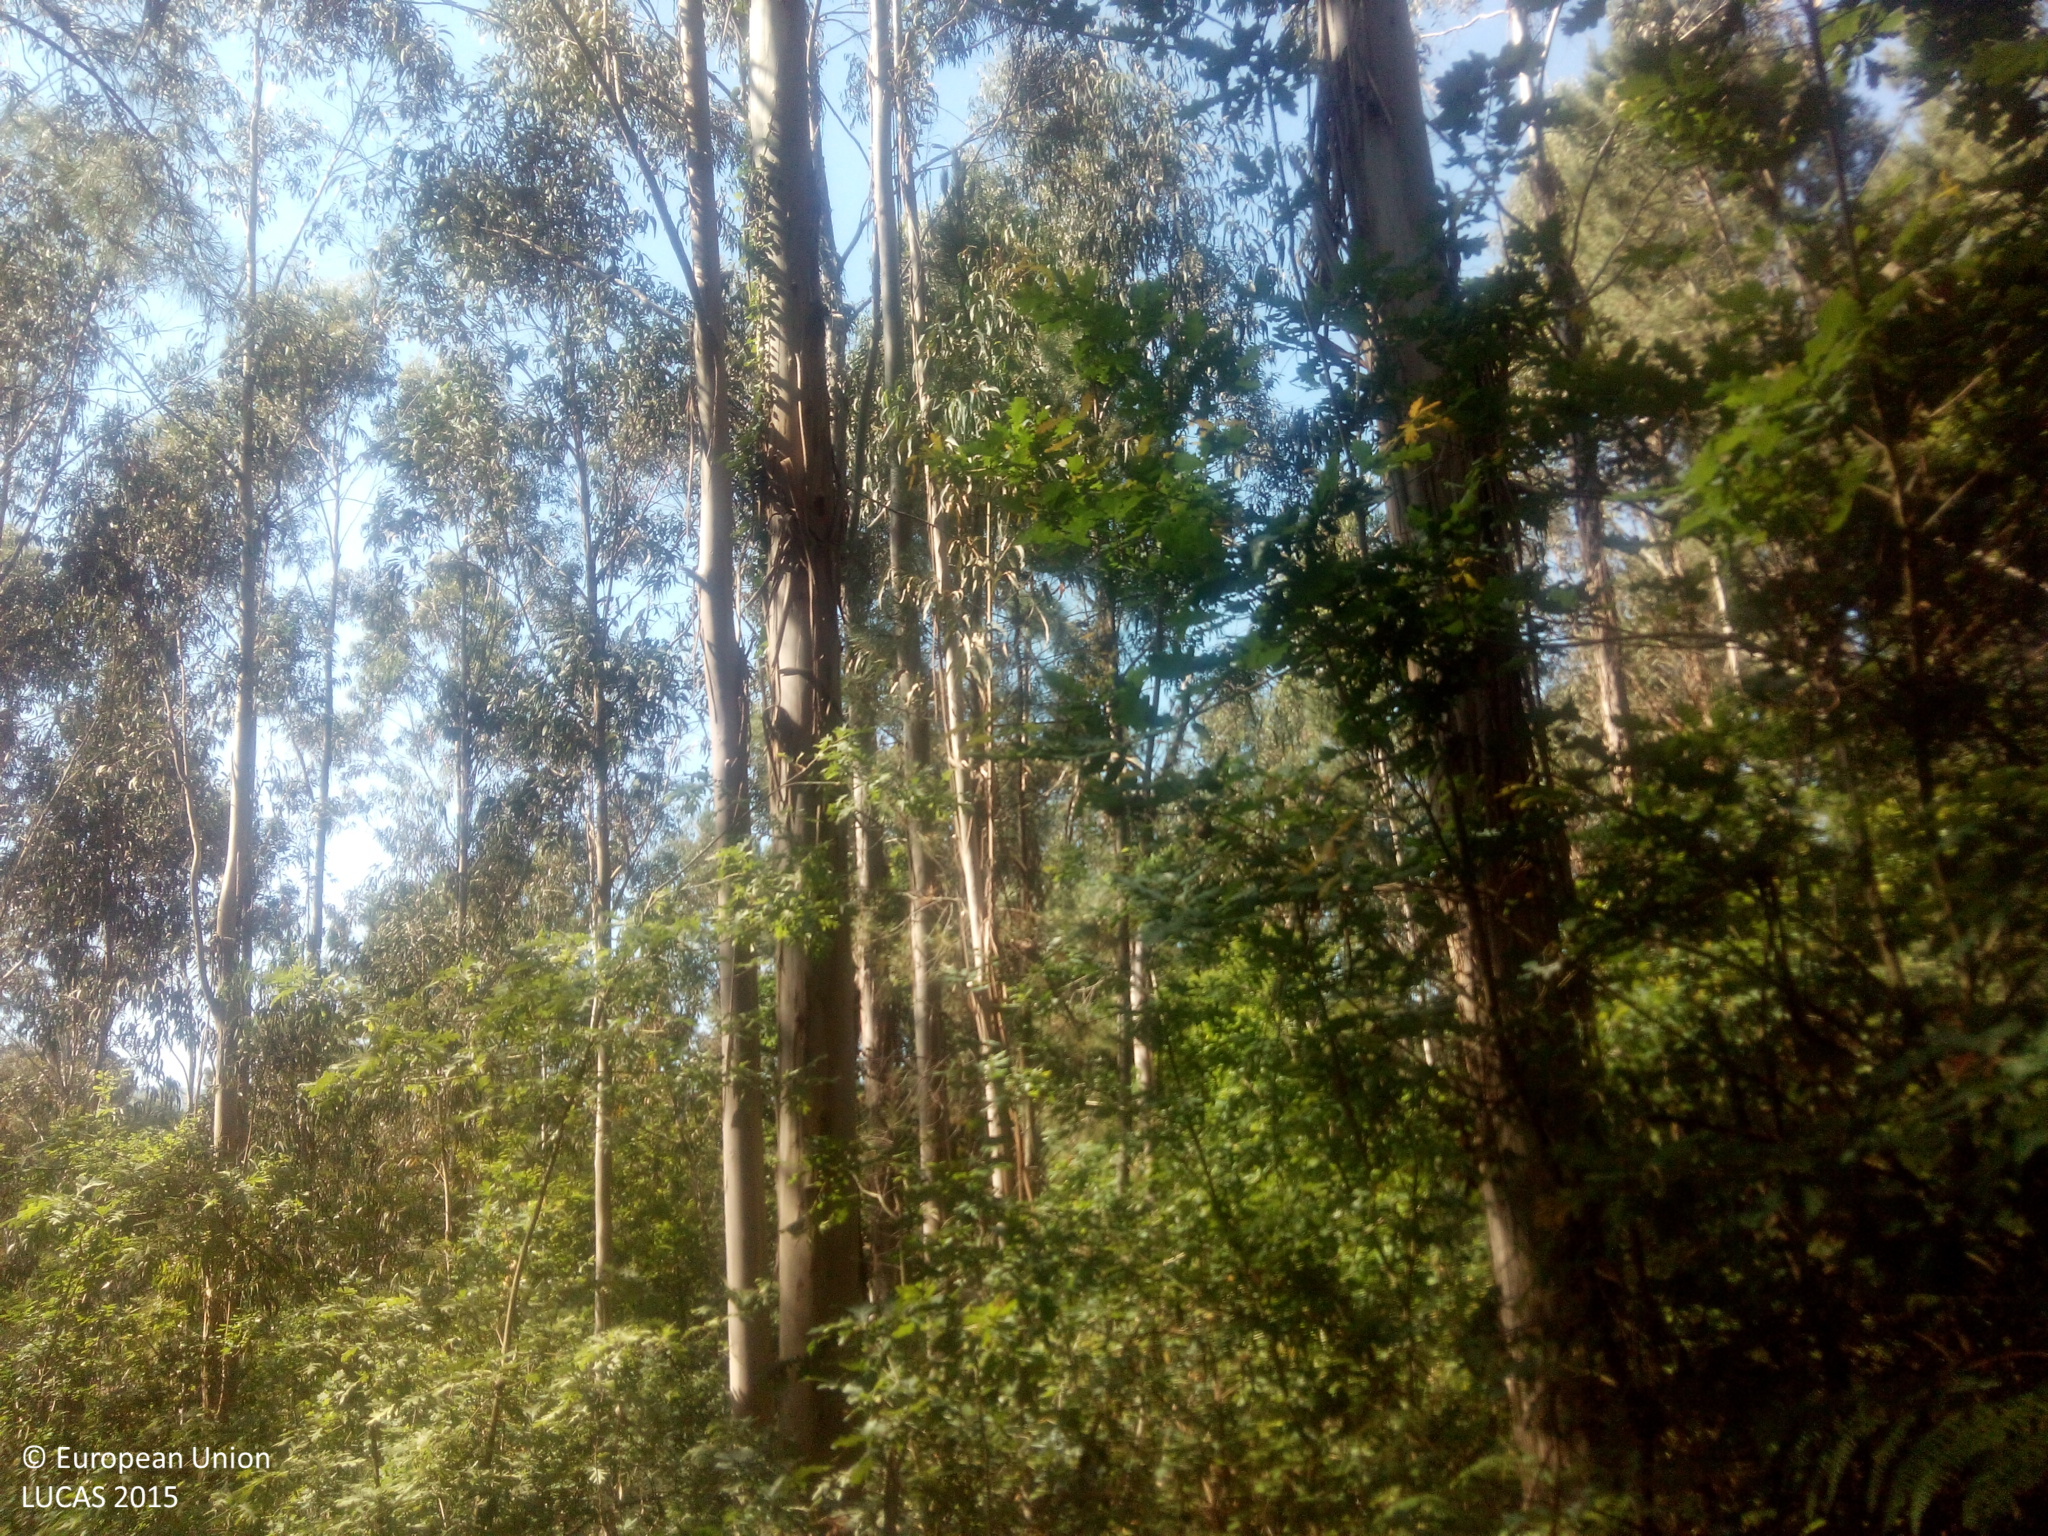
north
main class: Woodland
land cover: Broadleaved woodland
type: exotic forest
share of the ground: > 75 %
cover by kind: broadleaved forest trees 100 %
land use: Forestry
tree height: > 5 m
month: June
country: ES
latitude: 42.1738
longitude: -8.2819
